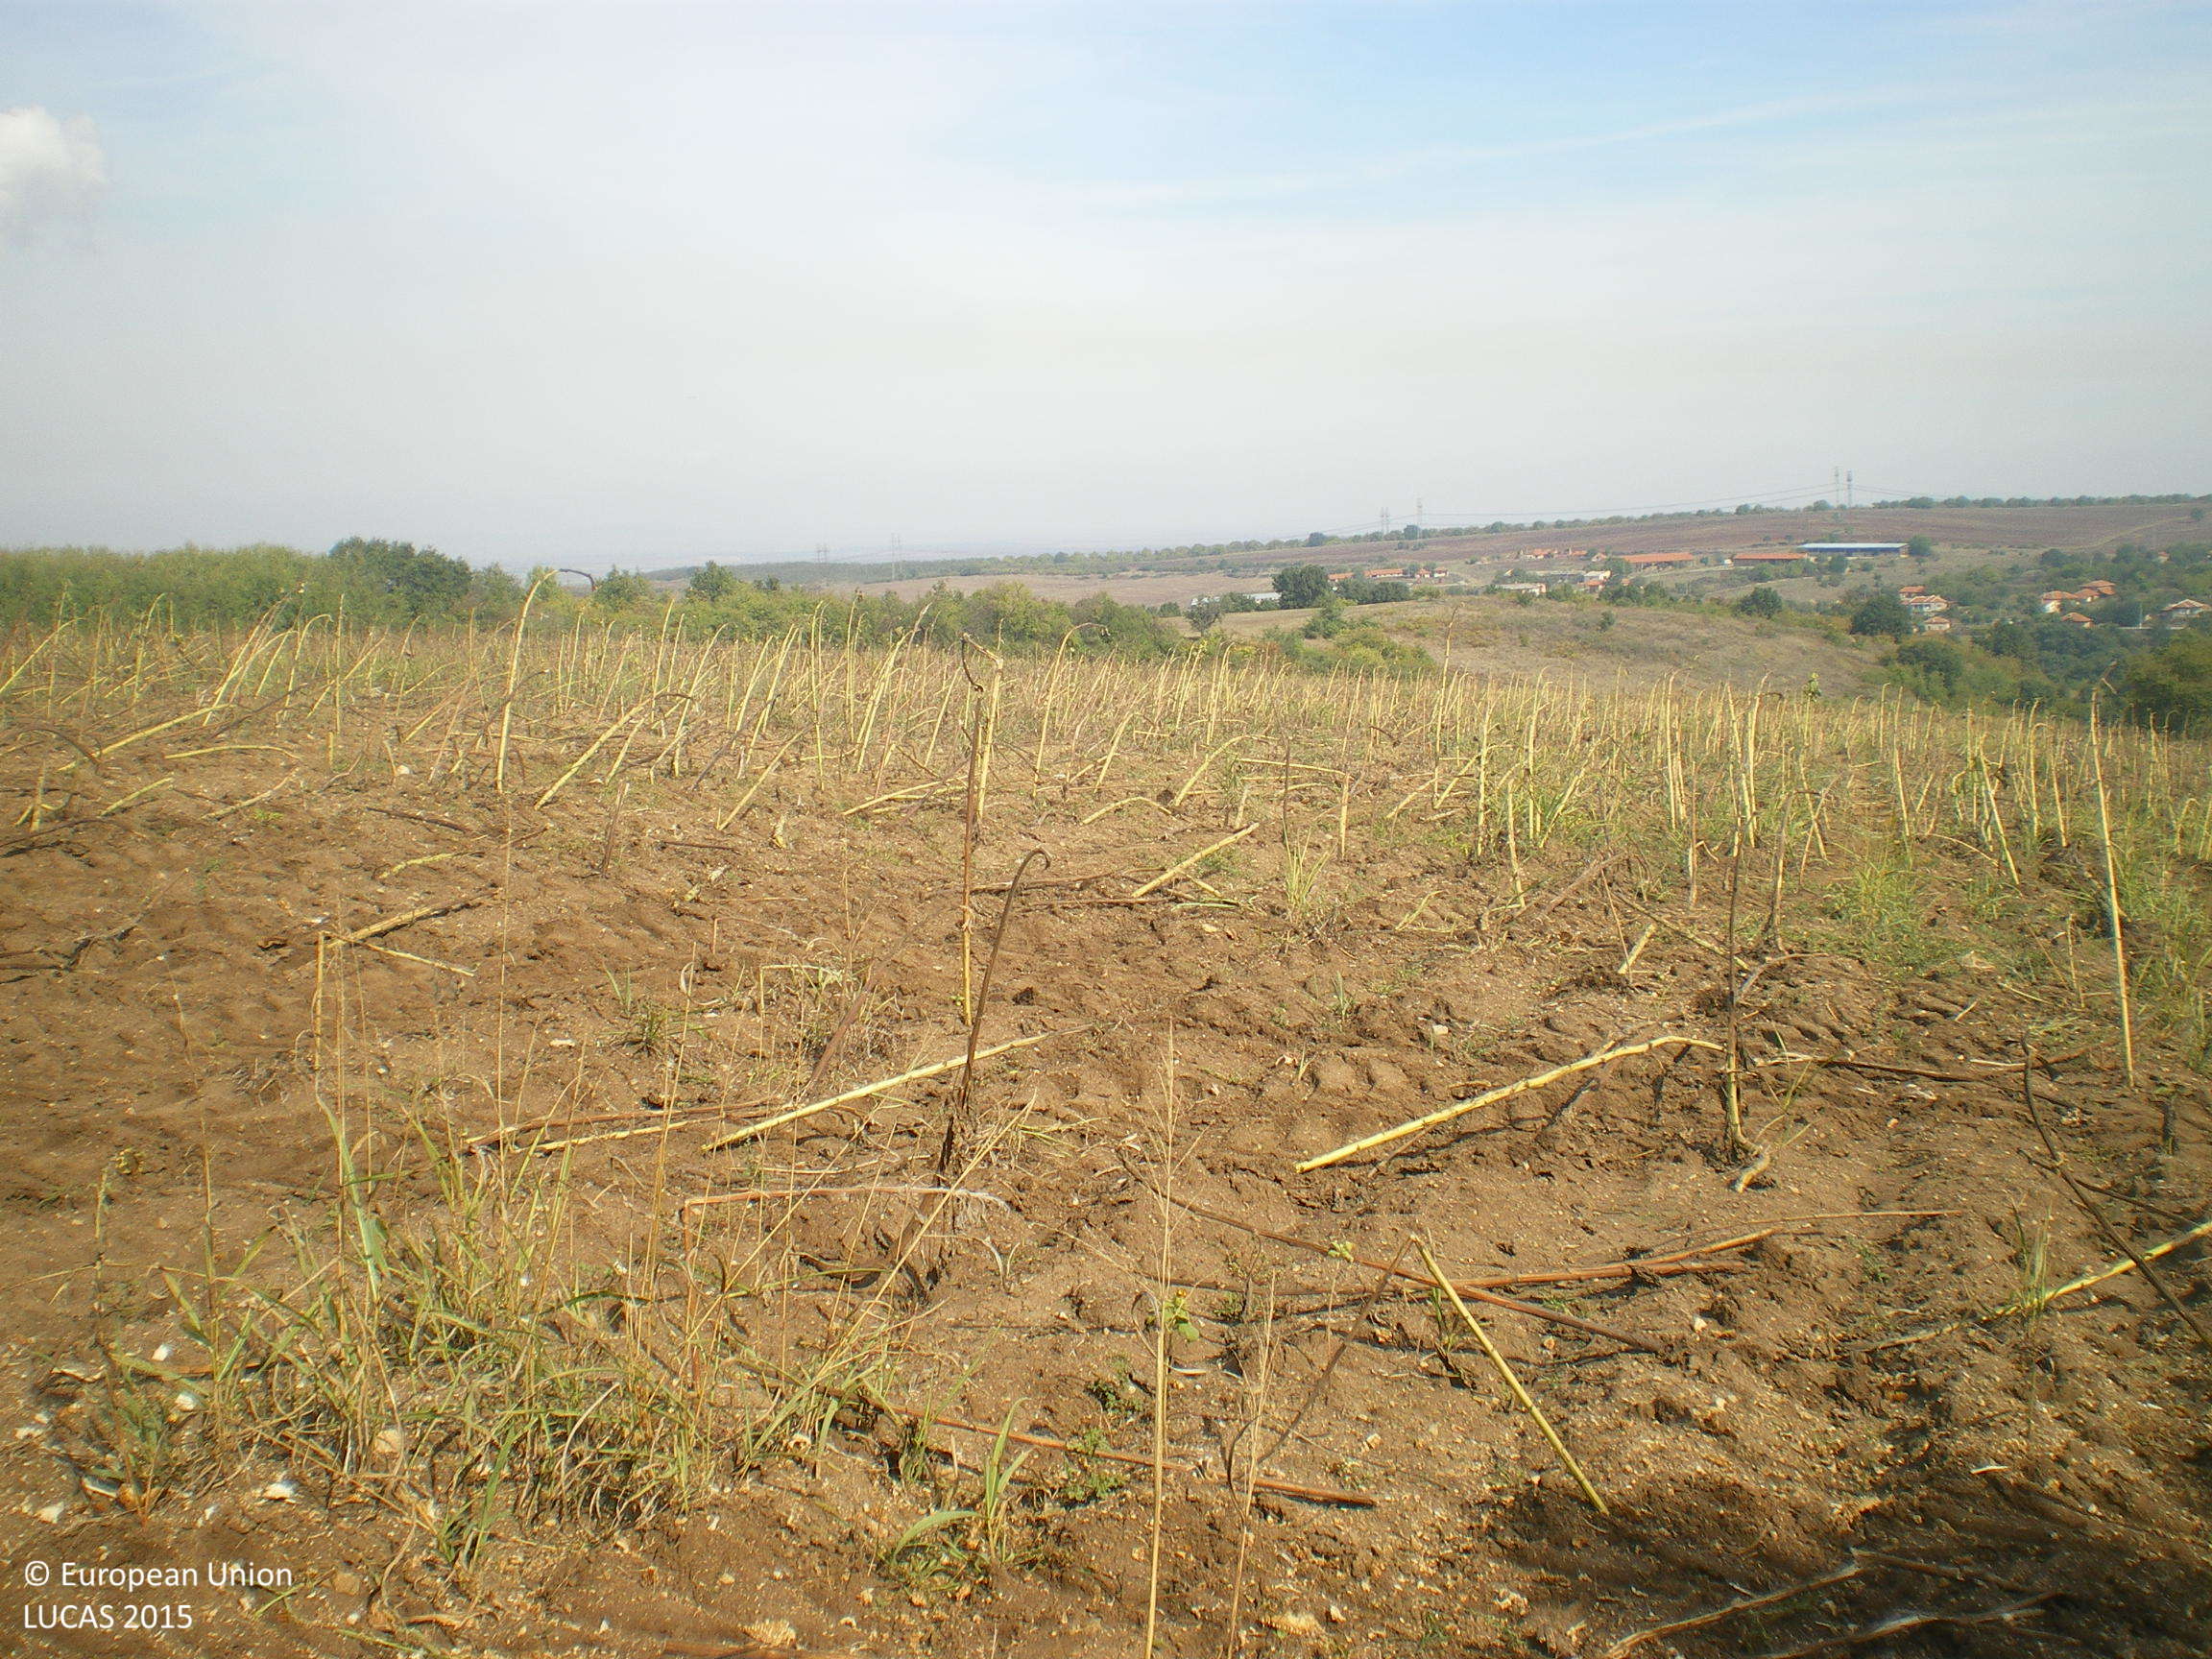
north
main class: Cropland
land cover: Sunflower
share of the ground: < 10 %
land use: Agriculture (excluding fallow land and kitchen gardens)
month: October
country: BG
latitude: 42.2111
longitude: 26.1544
